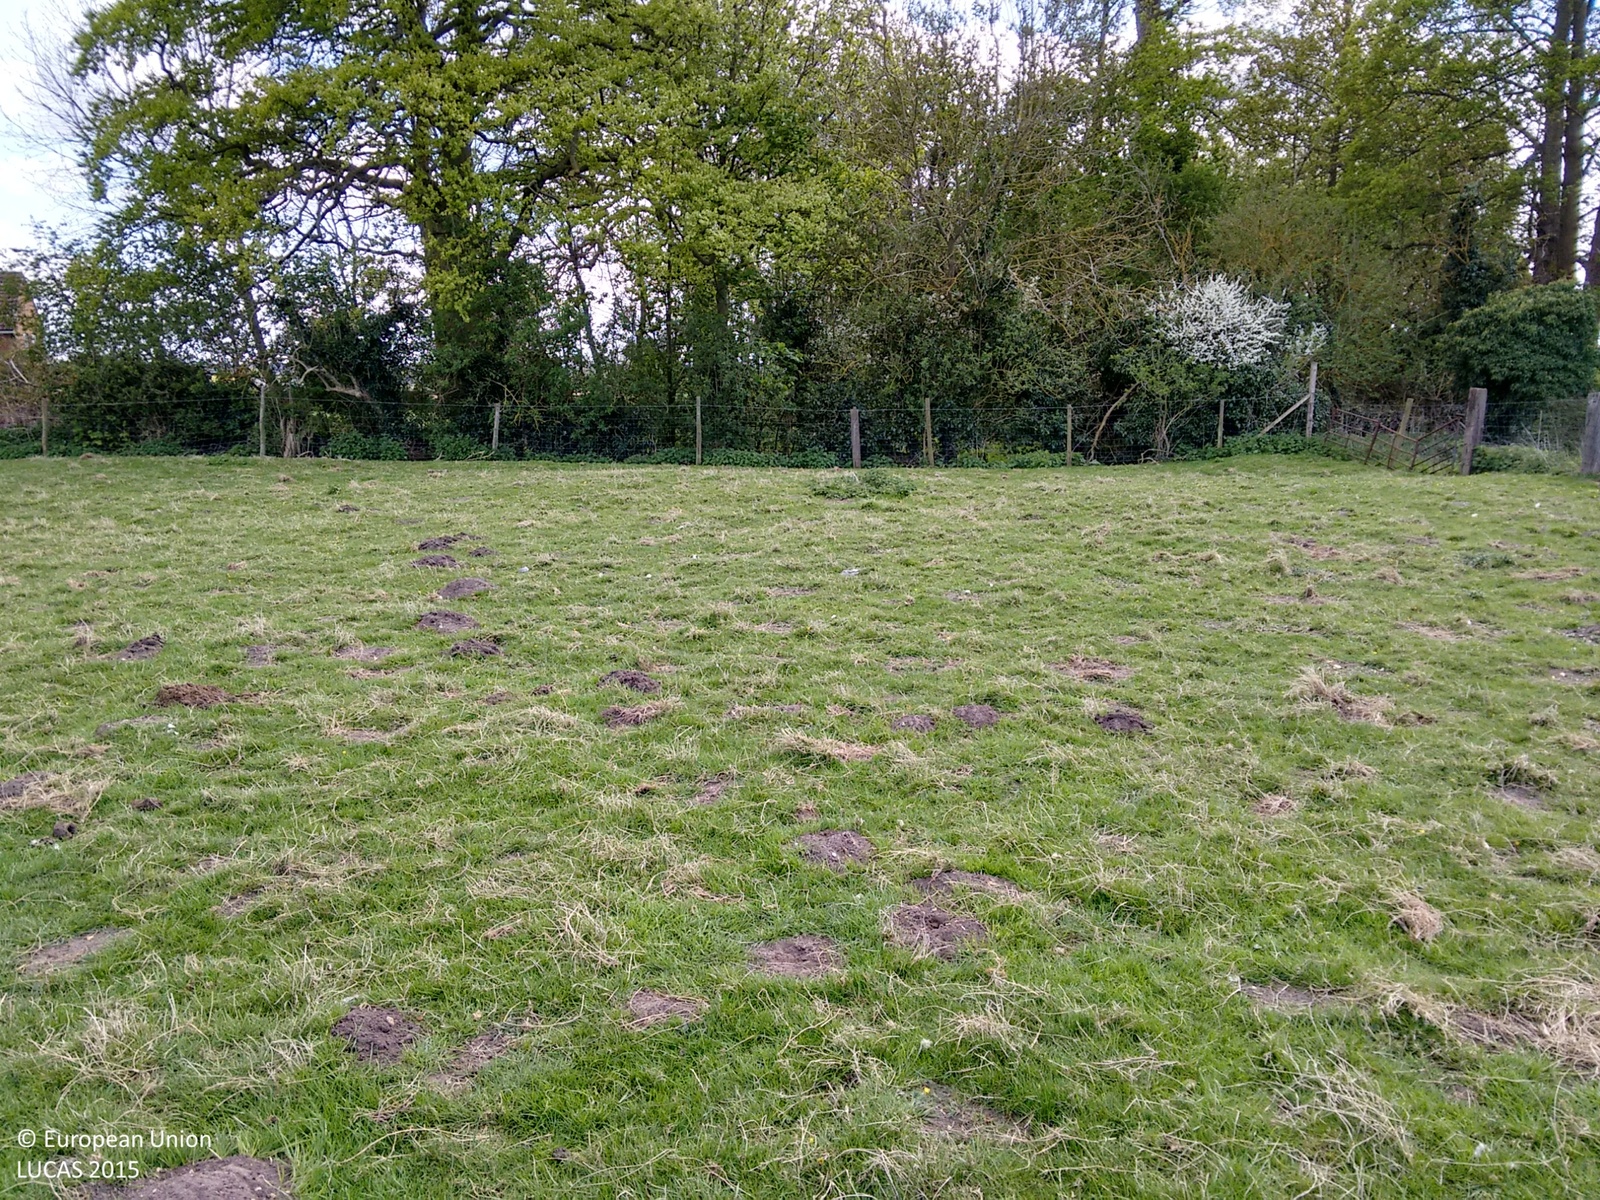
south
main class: Grassland
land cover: Grassland without tree/shrub cover
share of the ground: > 75 %
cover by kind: herbaceous plants 100 %
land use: Agriculture (excluding fallow land and kitchen gardens)
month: April
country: GB
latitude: 53.1930
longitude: -0.1365
